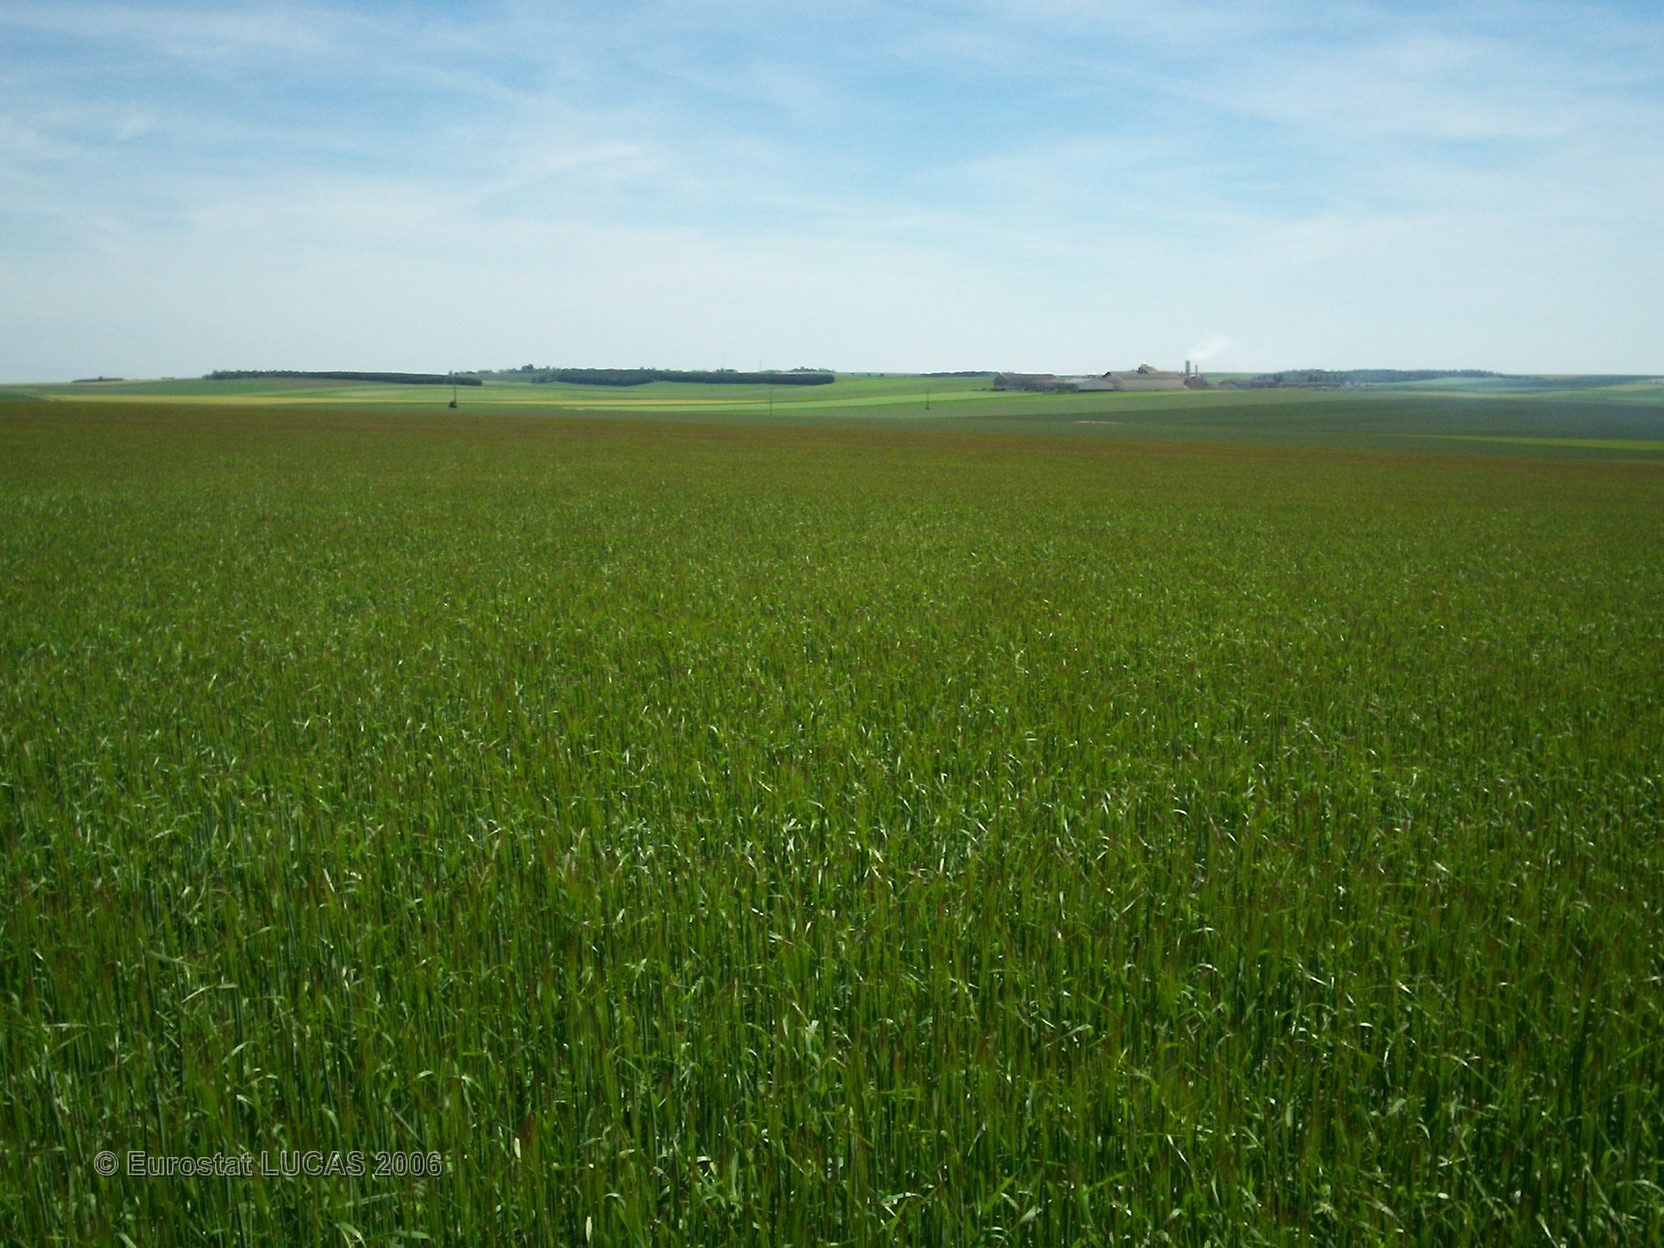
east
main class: Cropland
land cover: Barley
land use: Agriculture (excluding fallow land and kitchen gardens)
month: June
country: FR
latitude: 49.0645
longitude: 4.5906
